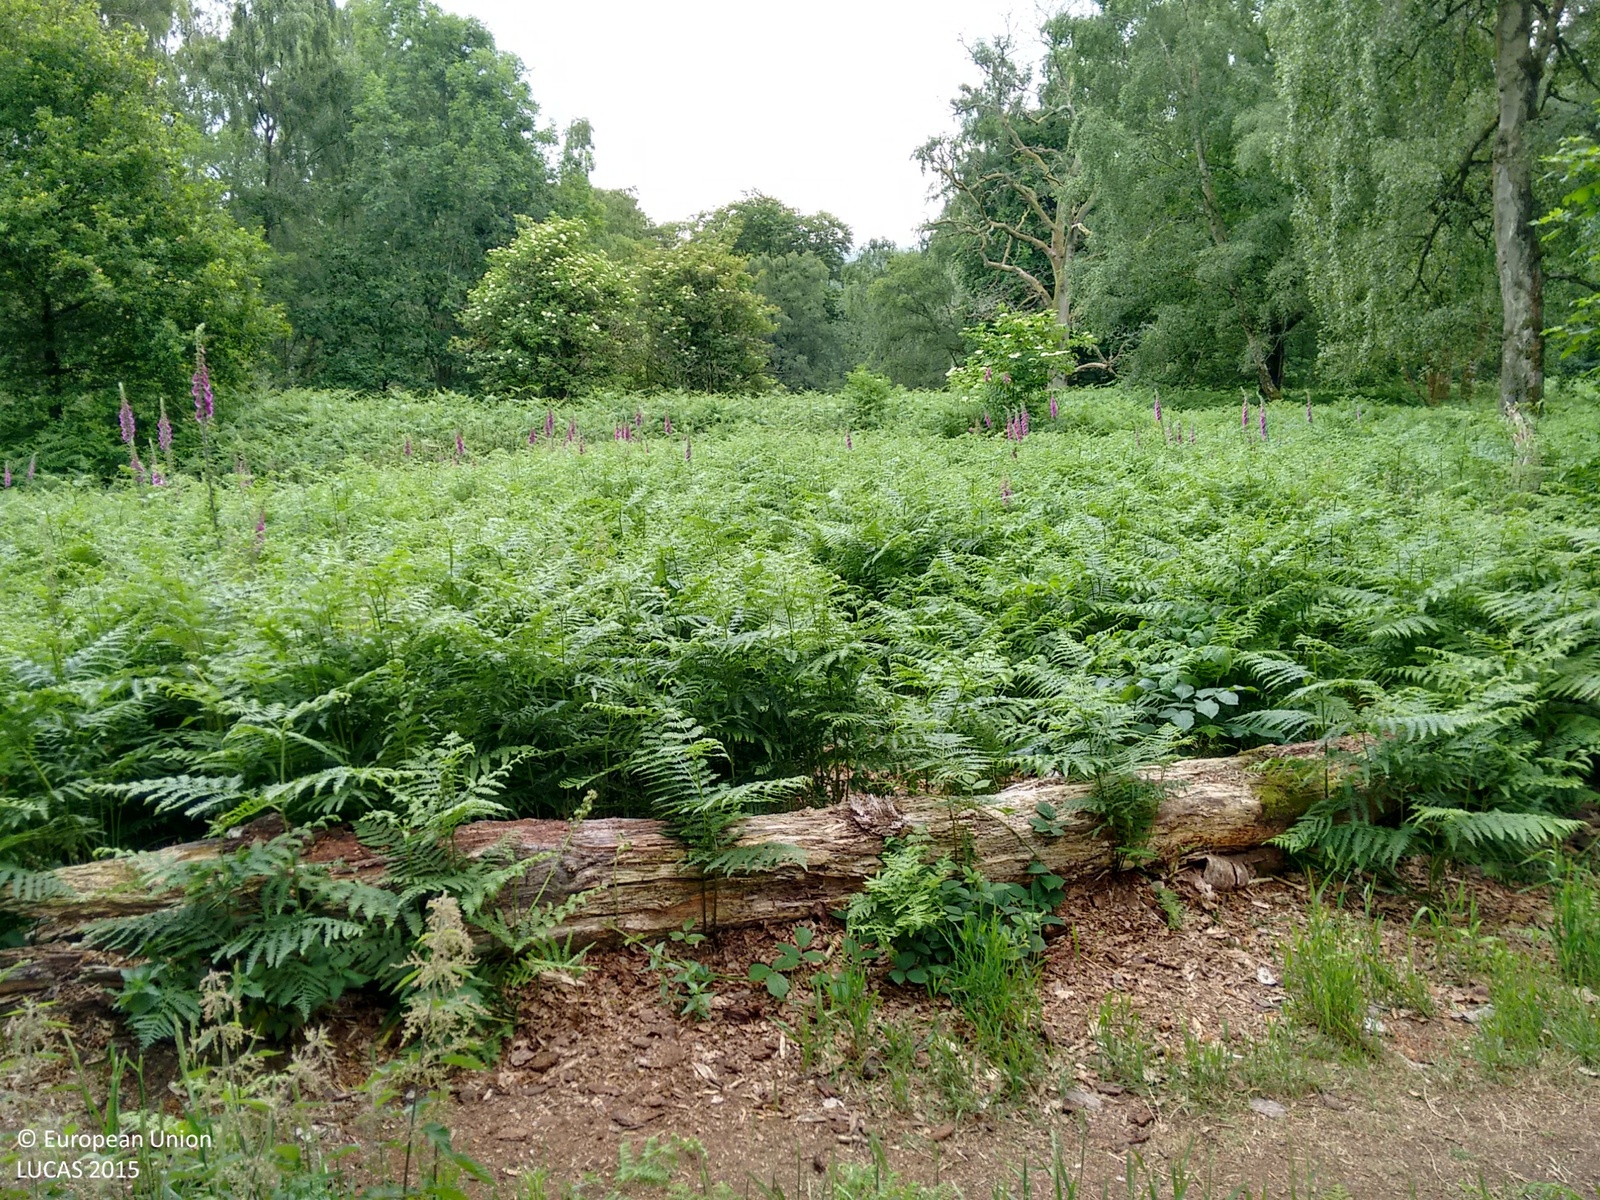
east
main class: Woodland
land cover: Broadleaved woodland
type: mesophytic deciduous forest
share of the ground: > 75 %
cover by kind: broadleaved forest trees 95 %, shrubs 5 %
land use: Semi-natural and natural areas not in use
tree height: > 5 m
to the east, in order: Broadleaved woodland; Tracks; Broadleaved woodland; Grass margins; Paved roads, cycling and walking lanes; Grass margins; Broadleaved woodland; Managed hedges; Grassland without tree/shrub cover
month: June
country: GB
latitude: 52.3433
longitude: -2.7380
